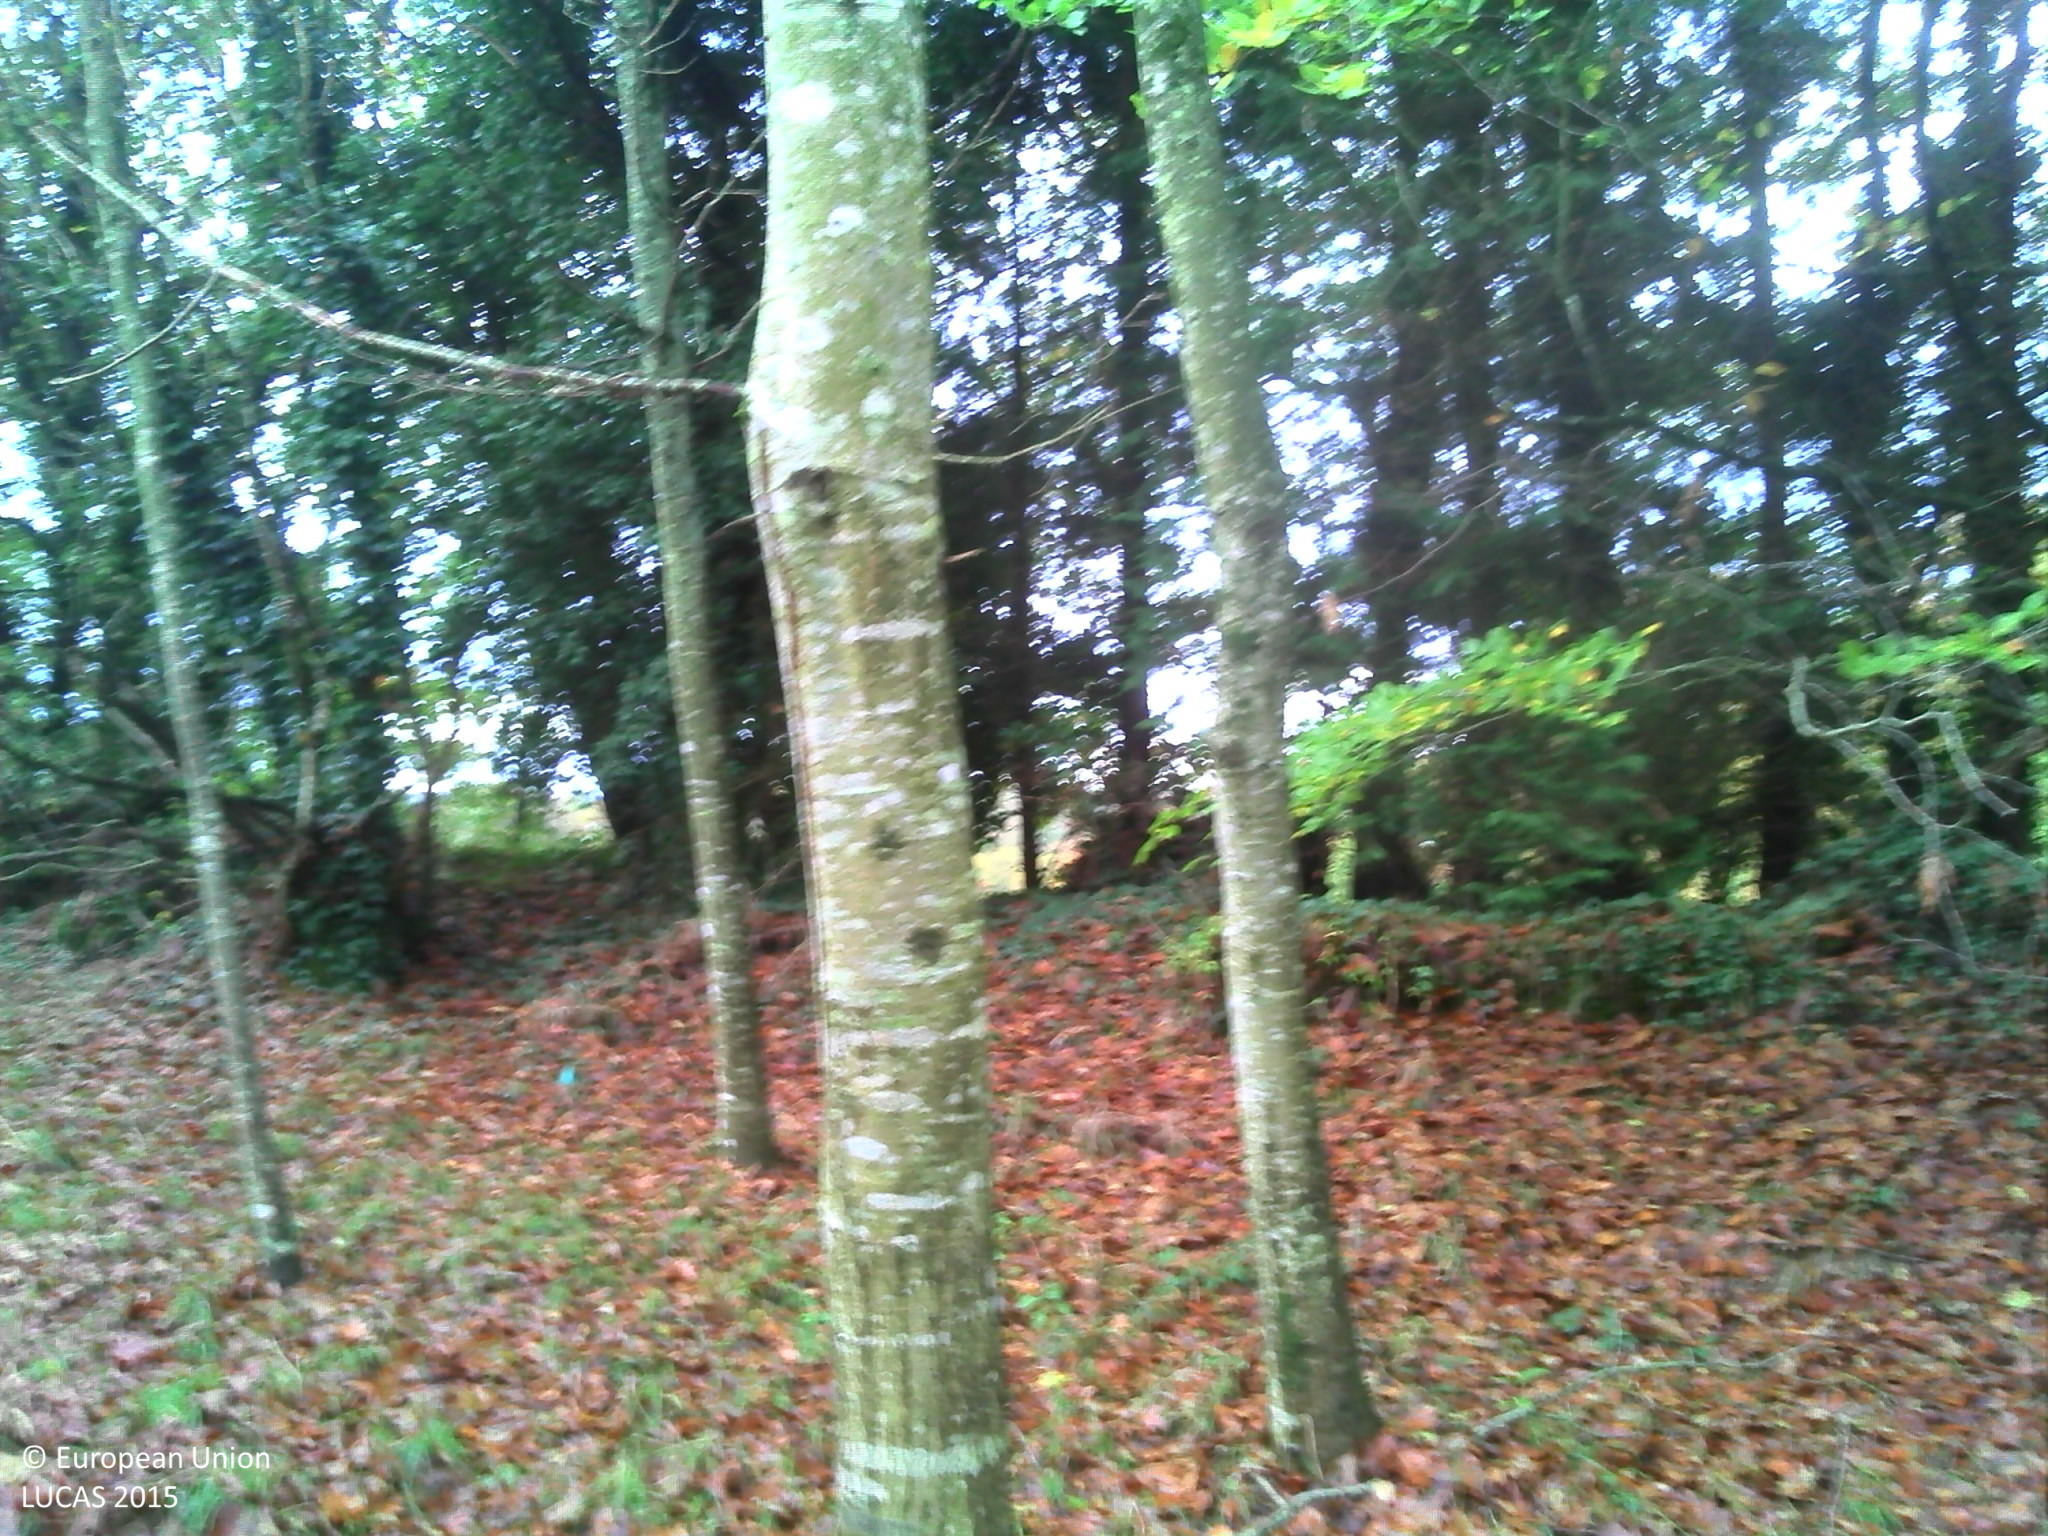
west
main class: Woodland
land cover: Broadleaved woodland
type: exotic forest
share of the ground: > 75 %
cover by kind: broadleaved forest trees 100 %
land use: Forestry
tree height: > 5 m
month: November
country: FR
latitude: 48.0111
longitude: -3.3316
